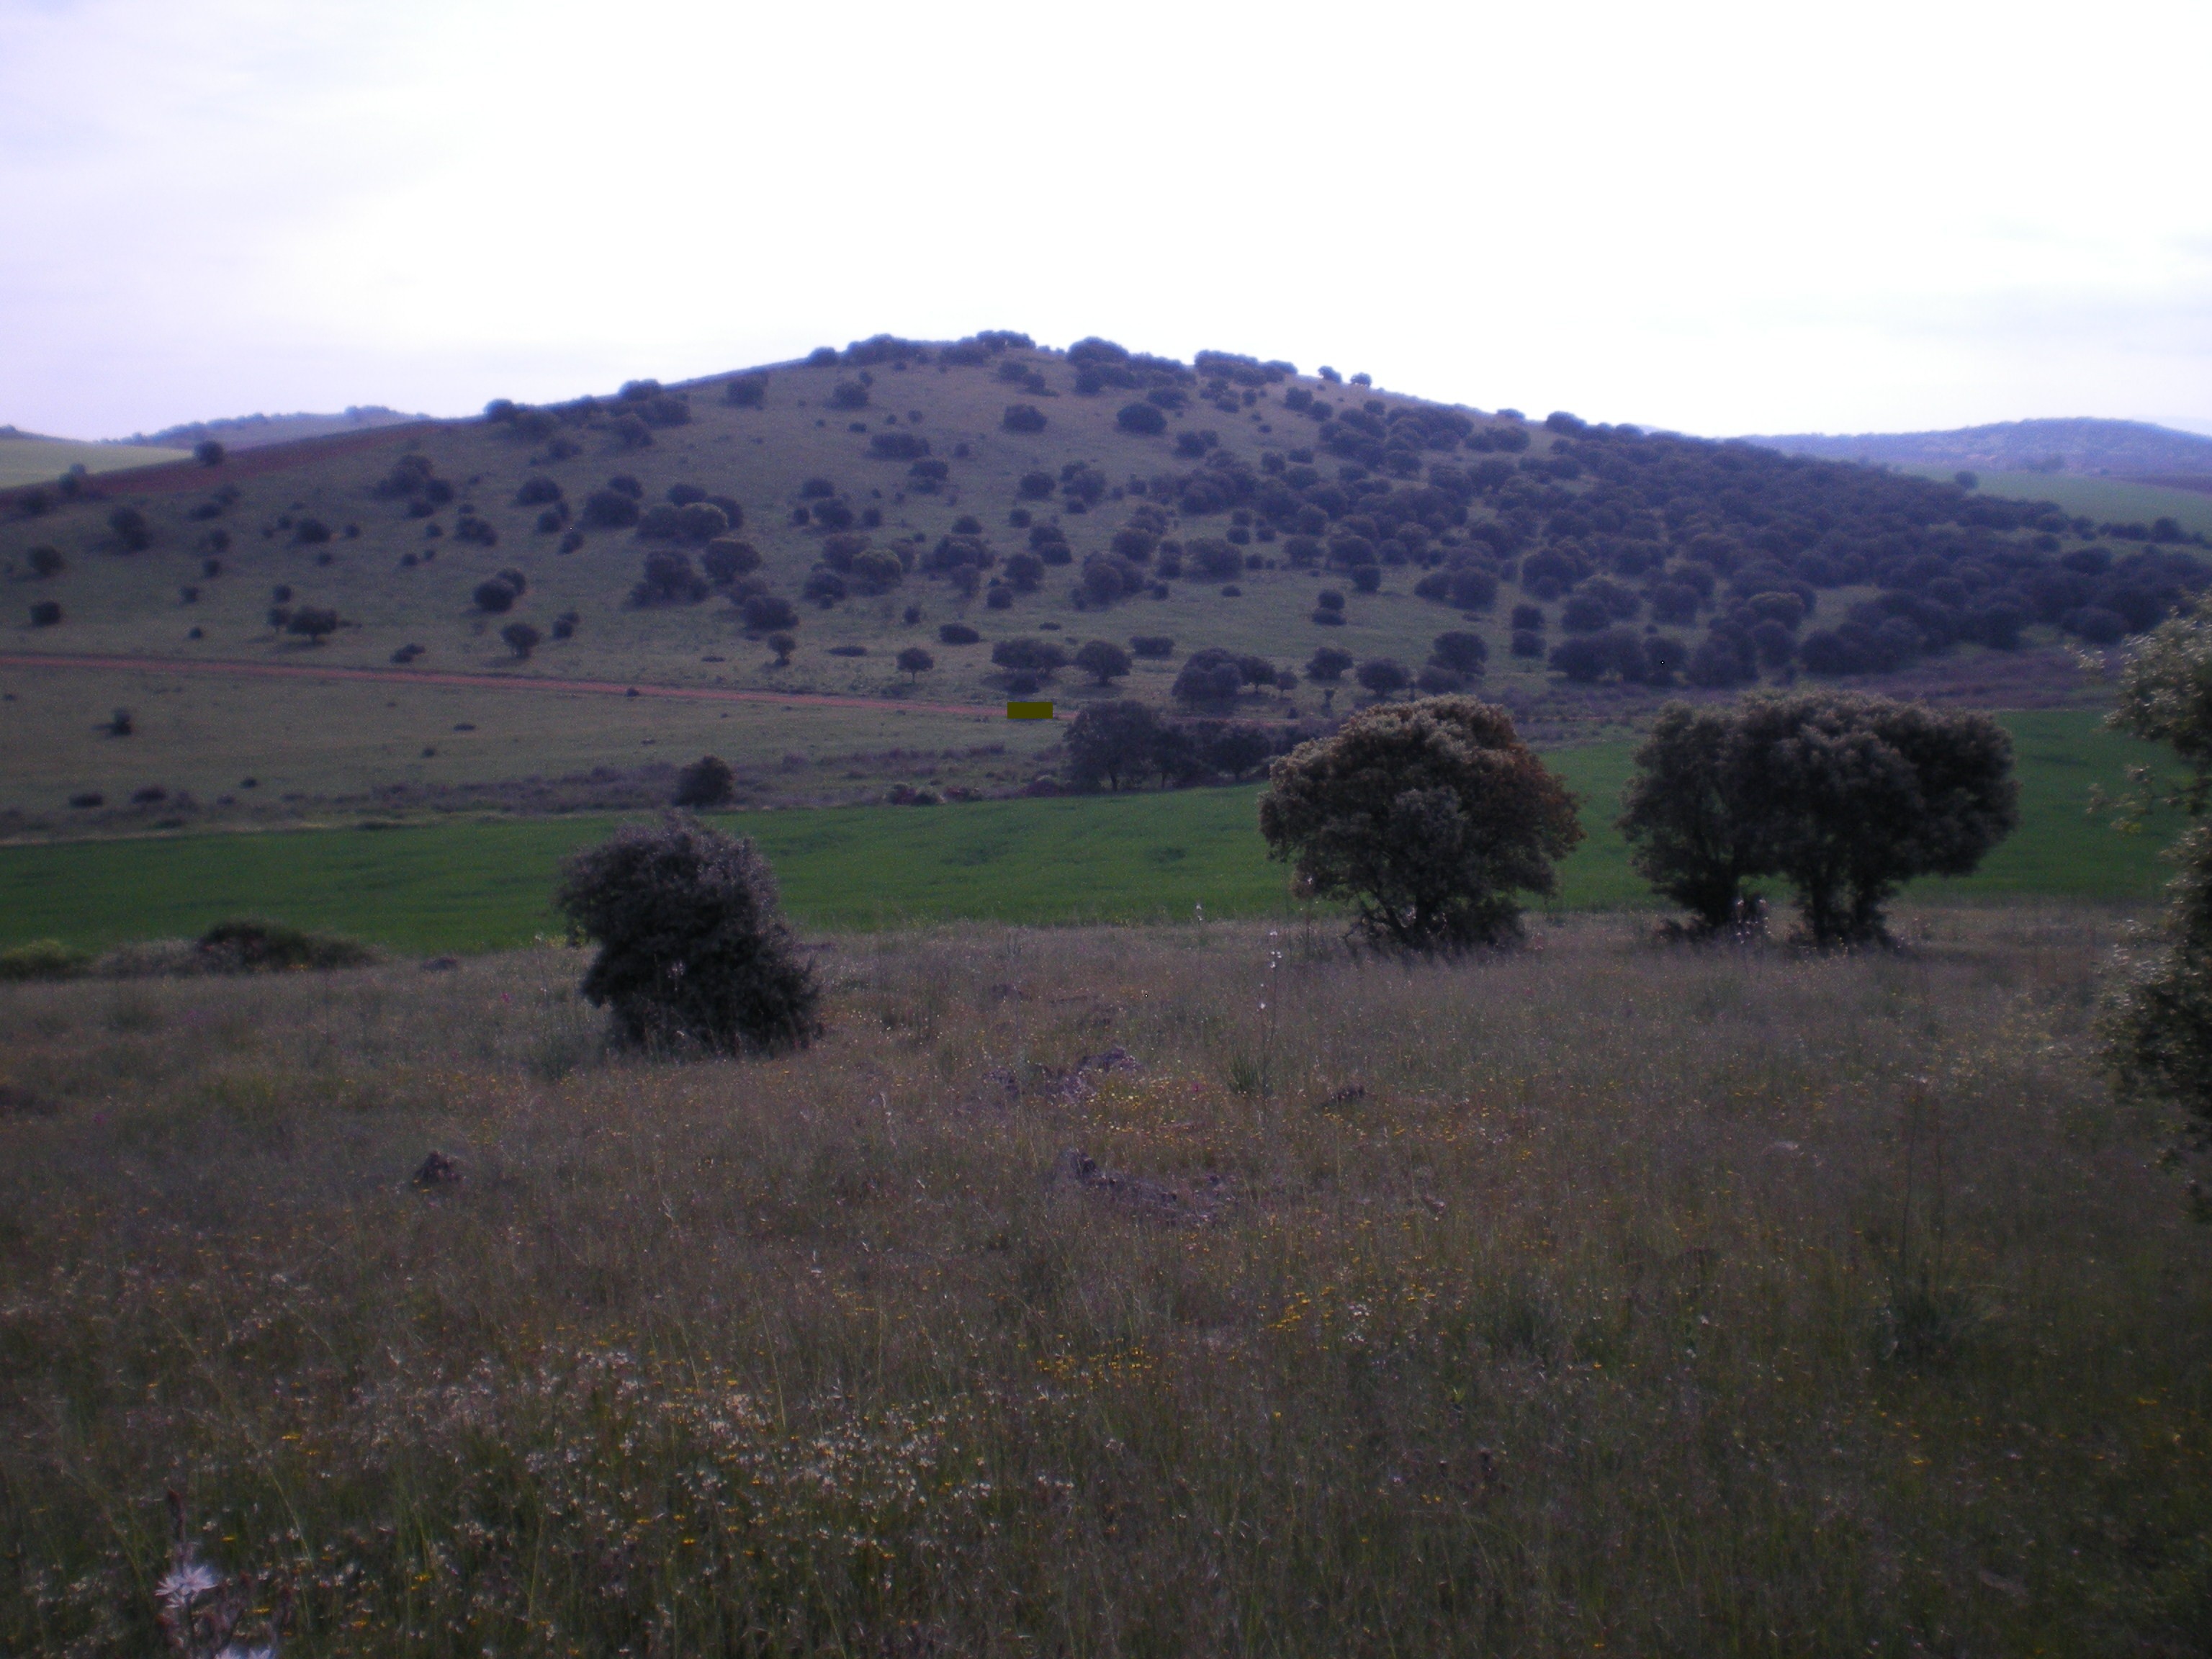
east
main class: Grassland
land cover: Grassland with sparse tree/shrub cover
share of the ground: > 75 %
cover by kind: herbaceous plants 80 %, consolidated bare surface 15 %, broadleaved forest trees 5 %
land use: Agriculture (excluding fallow land and kitchen gardens)
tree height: < 5 m
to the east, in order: Grassland with sparse tree/shrub cover; Durum wheat; Grassland with sparse tree/shrub cover; Tracks; Grassland without tree/shrub cover; Rivers and streams; Grassland without tree/shrub cover
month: April
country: ES
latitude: 38.7243
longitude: -3.5038
